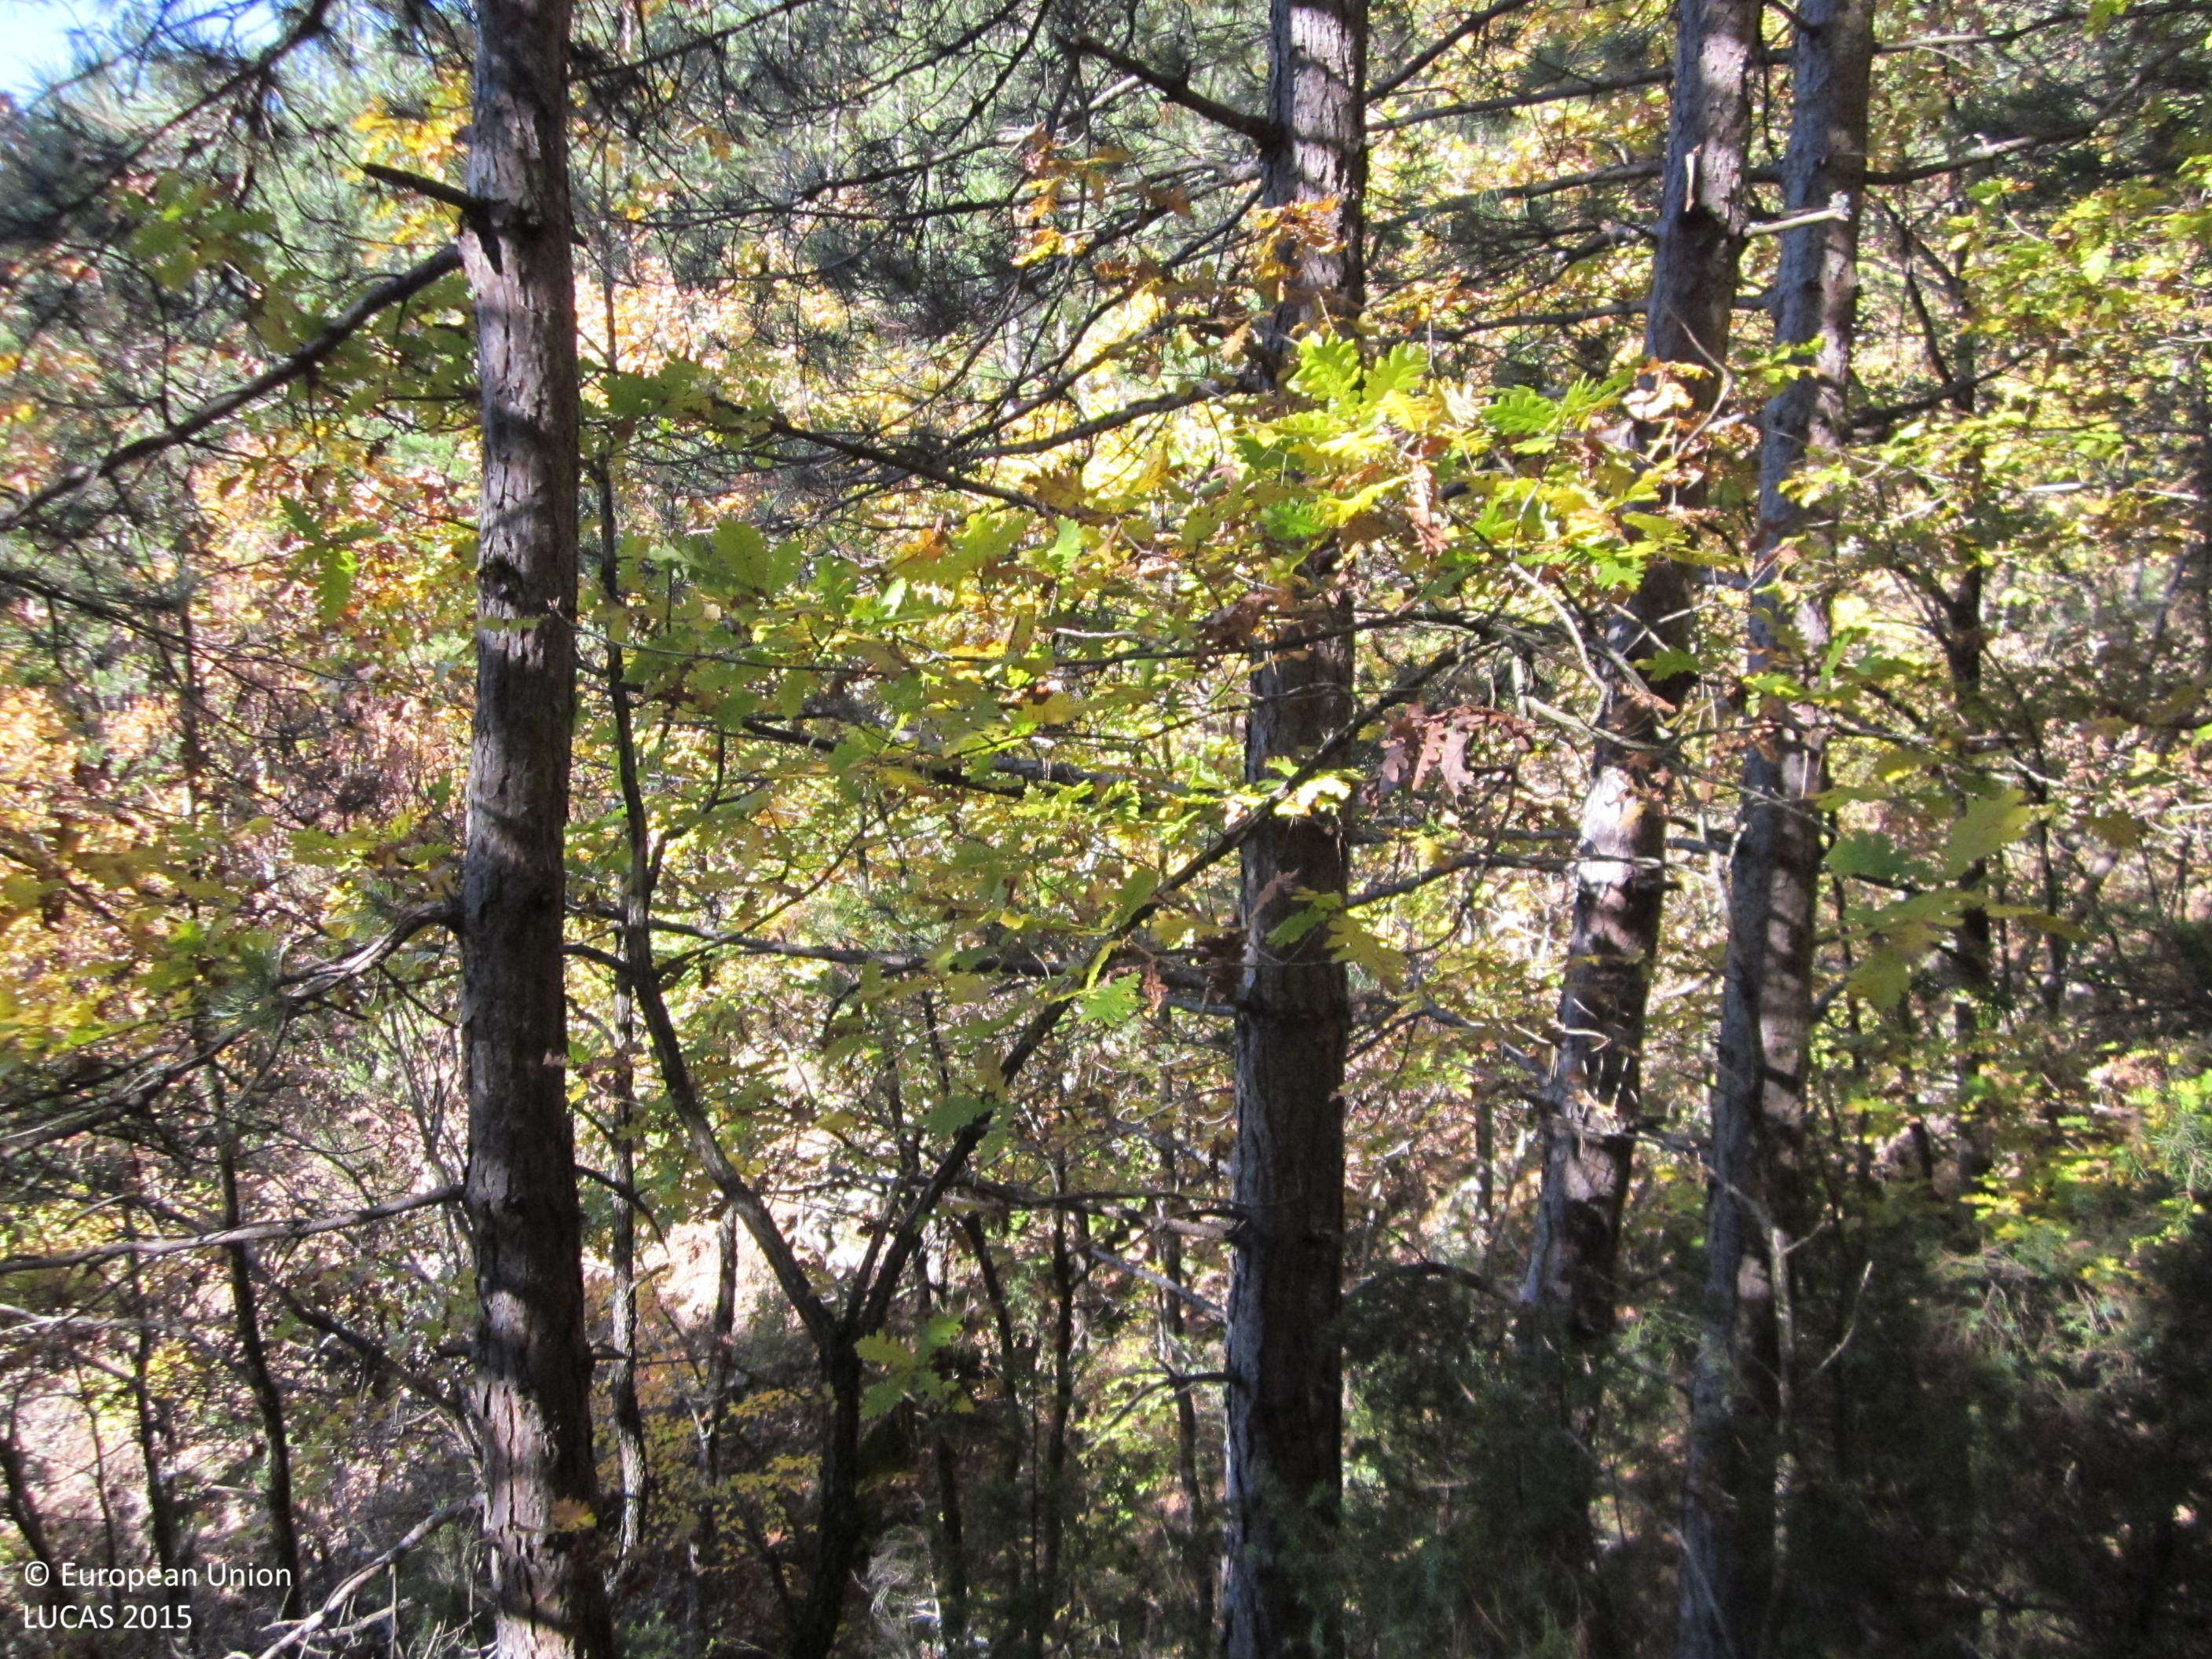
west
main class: Woodland
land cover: Pine dominated mixed woodland
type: hemiboreal forest and nemoral coniferous forest and mixed broadleaved-coniferous forest
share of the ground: > 75 %
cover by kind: coniferous forest trees 60 %, broadleaved forest trees 20 %, unconsolidated bare surface 10 %, shrubs 5 %, lichens and mosses 5 %
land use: Forestry
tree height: > 5 m
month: November
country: BG
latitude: 41.4033
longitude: 25.6941
